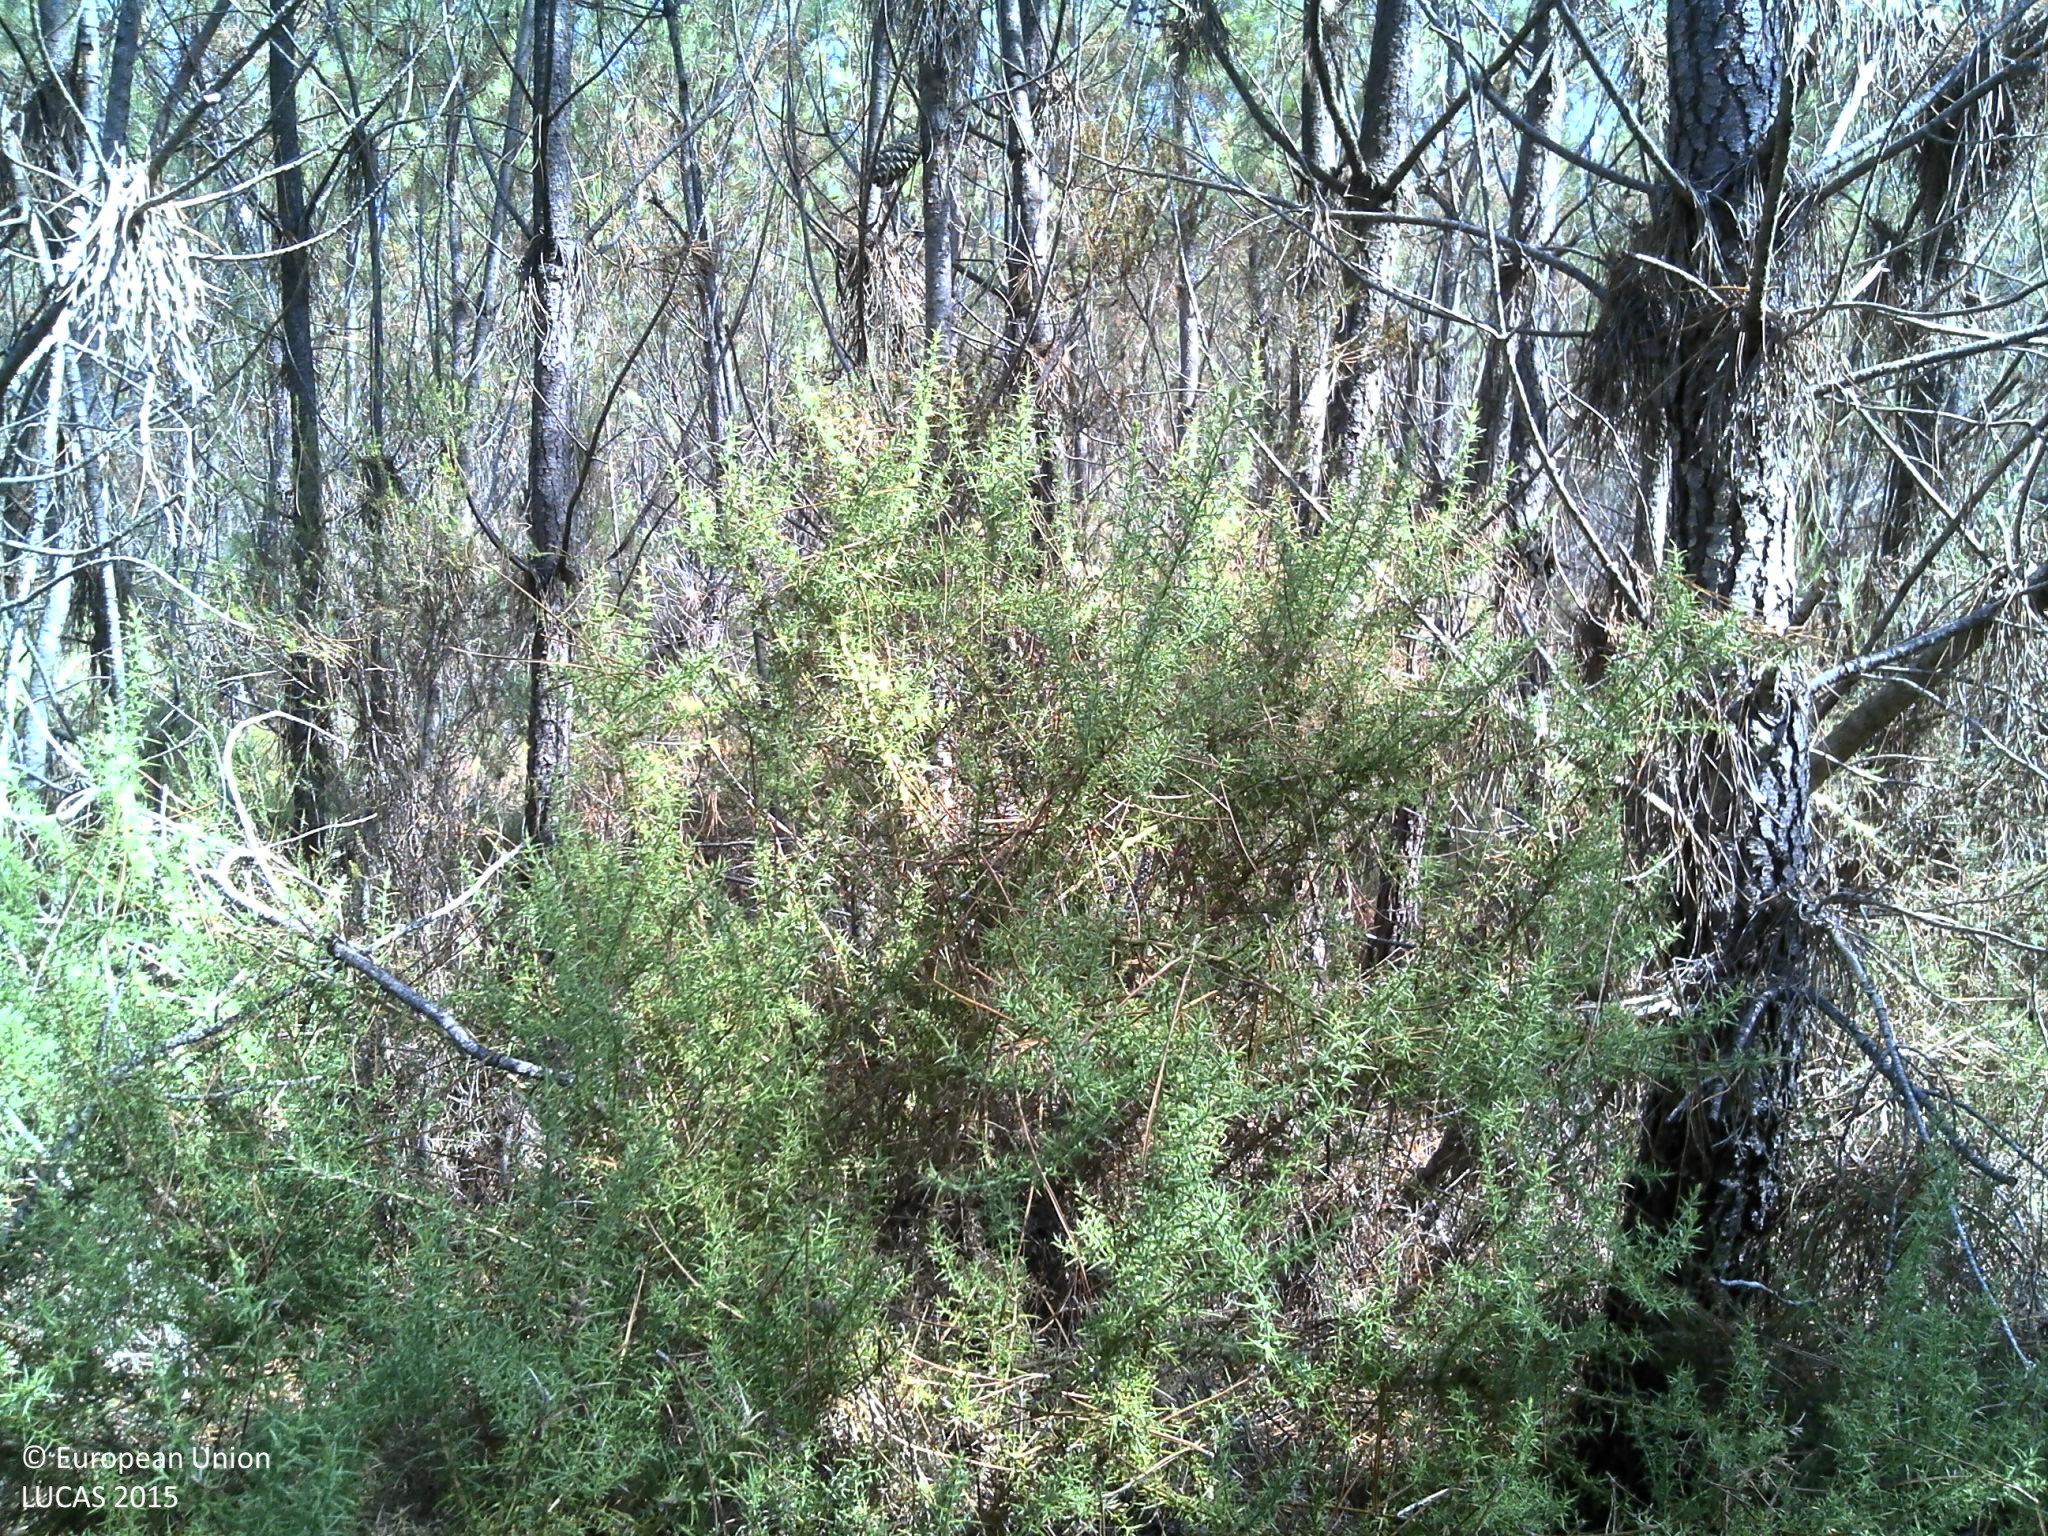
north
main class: Woodland
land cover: Pine dominated coniferous woodland
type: coniferous forest of the mediterranean region
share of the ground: > 75 %
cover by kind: coniferous forest trees 60 %, shrubs 30 %, herbaceous plants 5 %, lichens and mosses 5 %
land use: Forestry
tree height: > 5 m
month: July
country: FR
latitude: 44.4134
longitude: -0.5269
